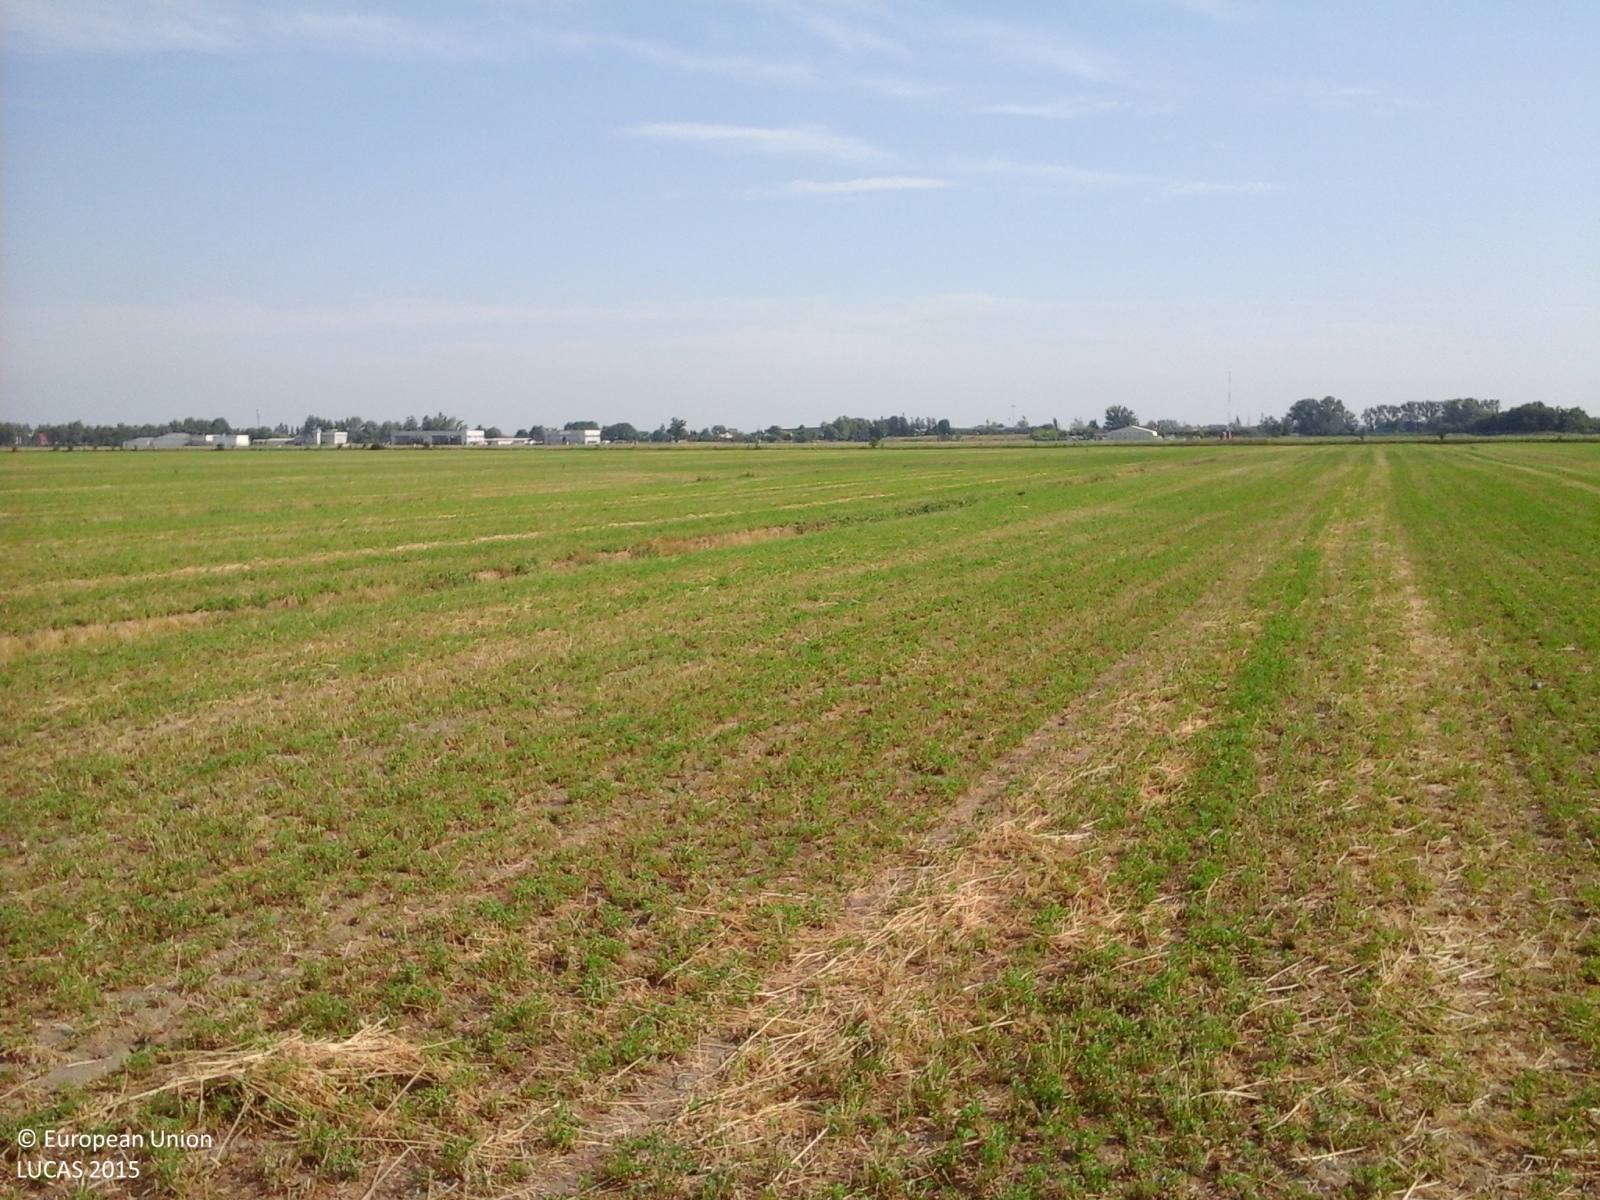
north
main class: Cropland
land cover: Lucerne
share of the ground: > 75 %
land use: Agriculture (excluding fallow land and kitchen gardens)
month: June
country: IT
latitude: 44.6911
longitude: 10.6674
